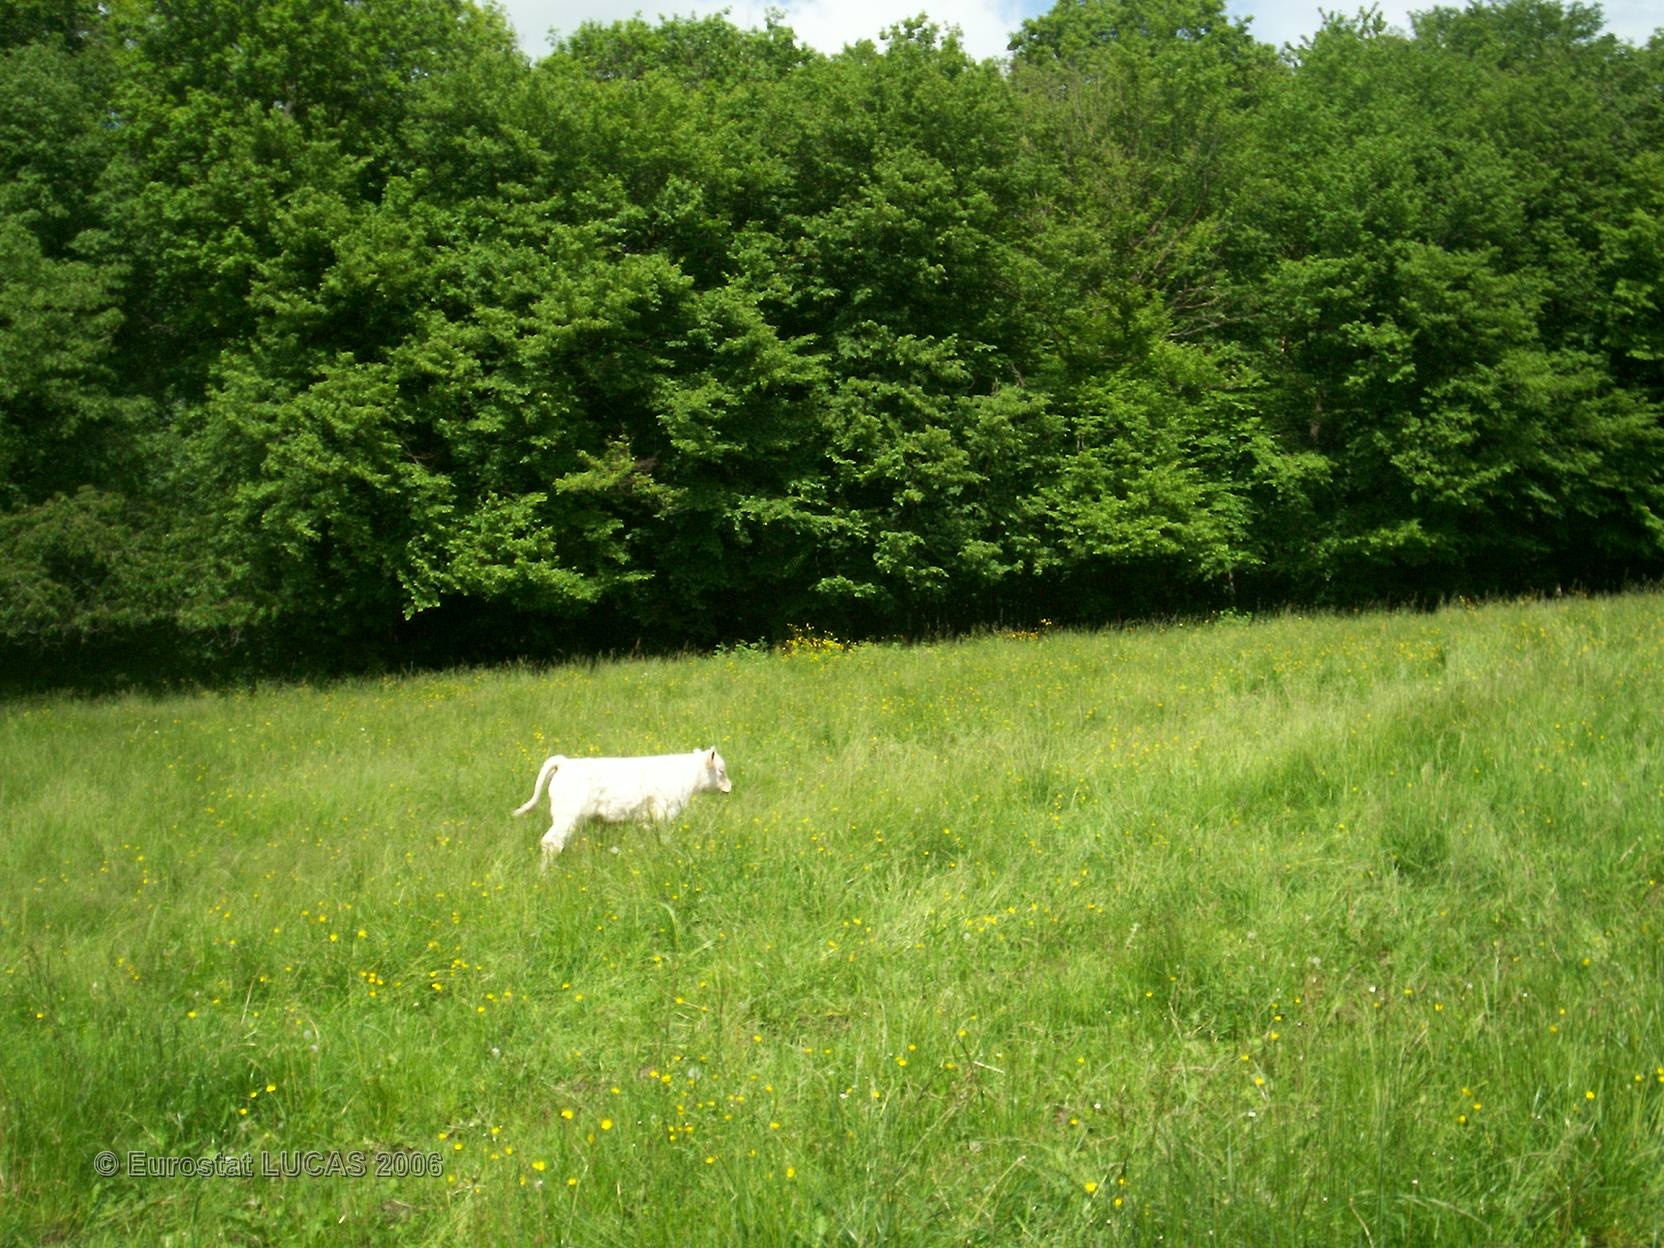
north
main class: Grassland
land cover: Grassland without tree/shrub cover
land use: Agriculture (excluding fallow land and kitchen gardens)
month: May
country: FR
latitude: 46.9907
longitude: 4.5962
